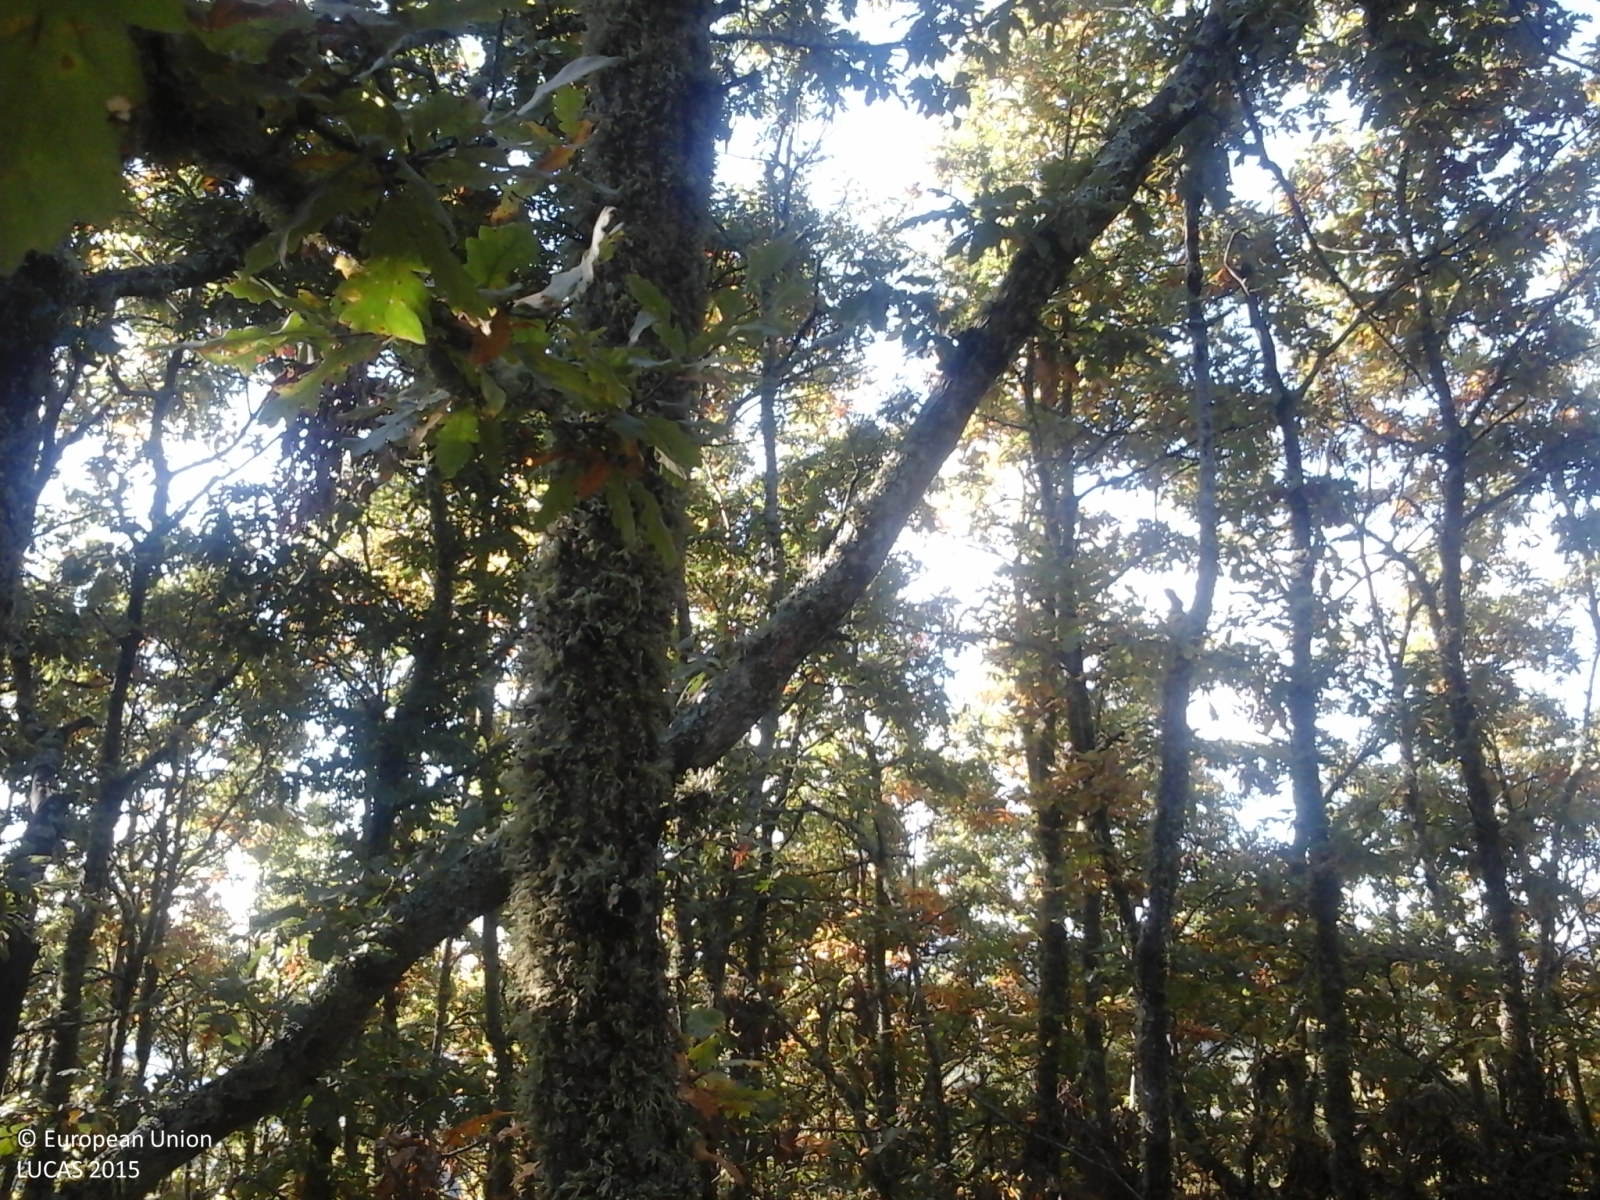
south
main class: Woodland
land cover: Broadleaved woodland
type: thermophilous deciduous forest
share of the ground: > 75 %
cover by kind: broadleaved forest trees 90 %, shrubs 5 %, herbaceous plants 5 %
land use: Forestry
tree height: > 5 m
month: October
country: IT
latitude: 43.4273
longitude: 12.0819
